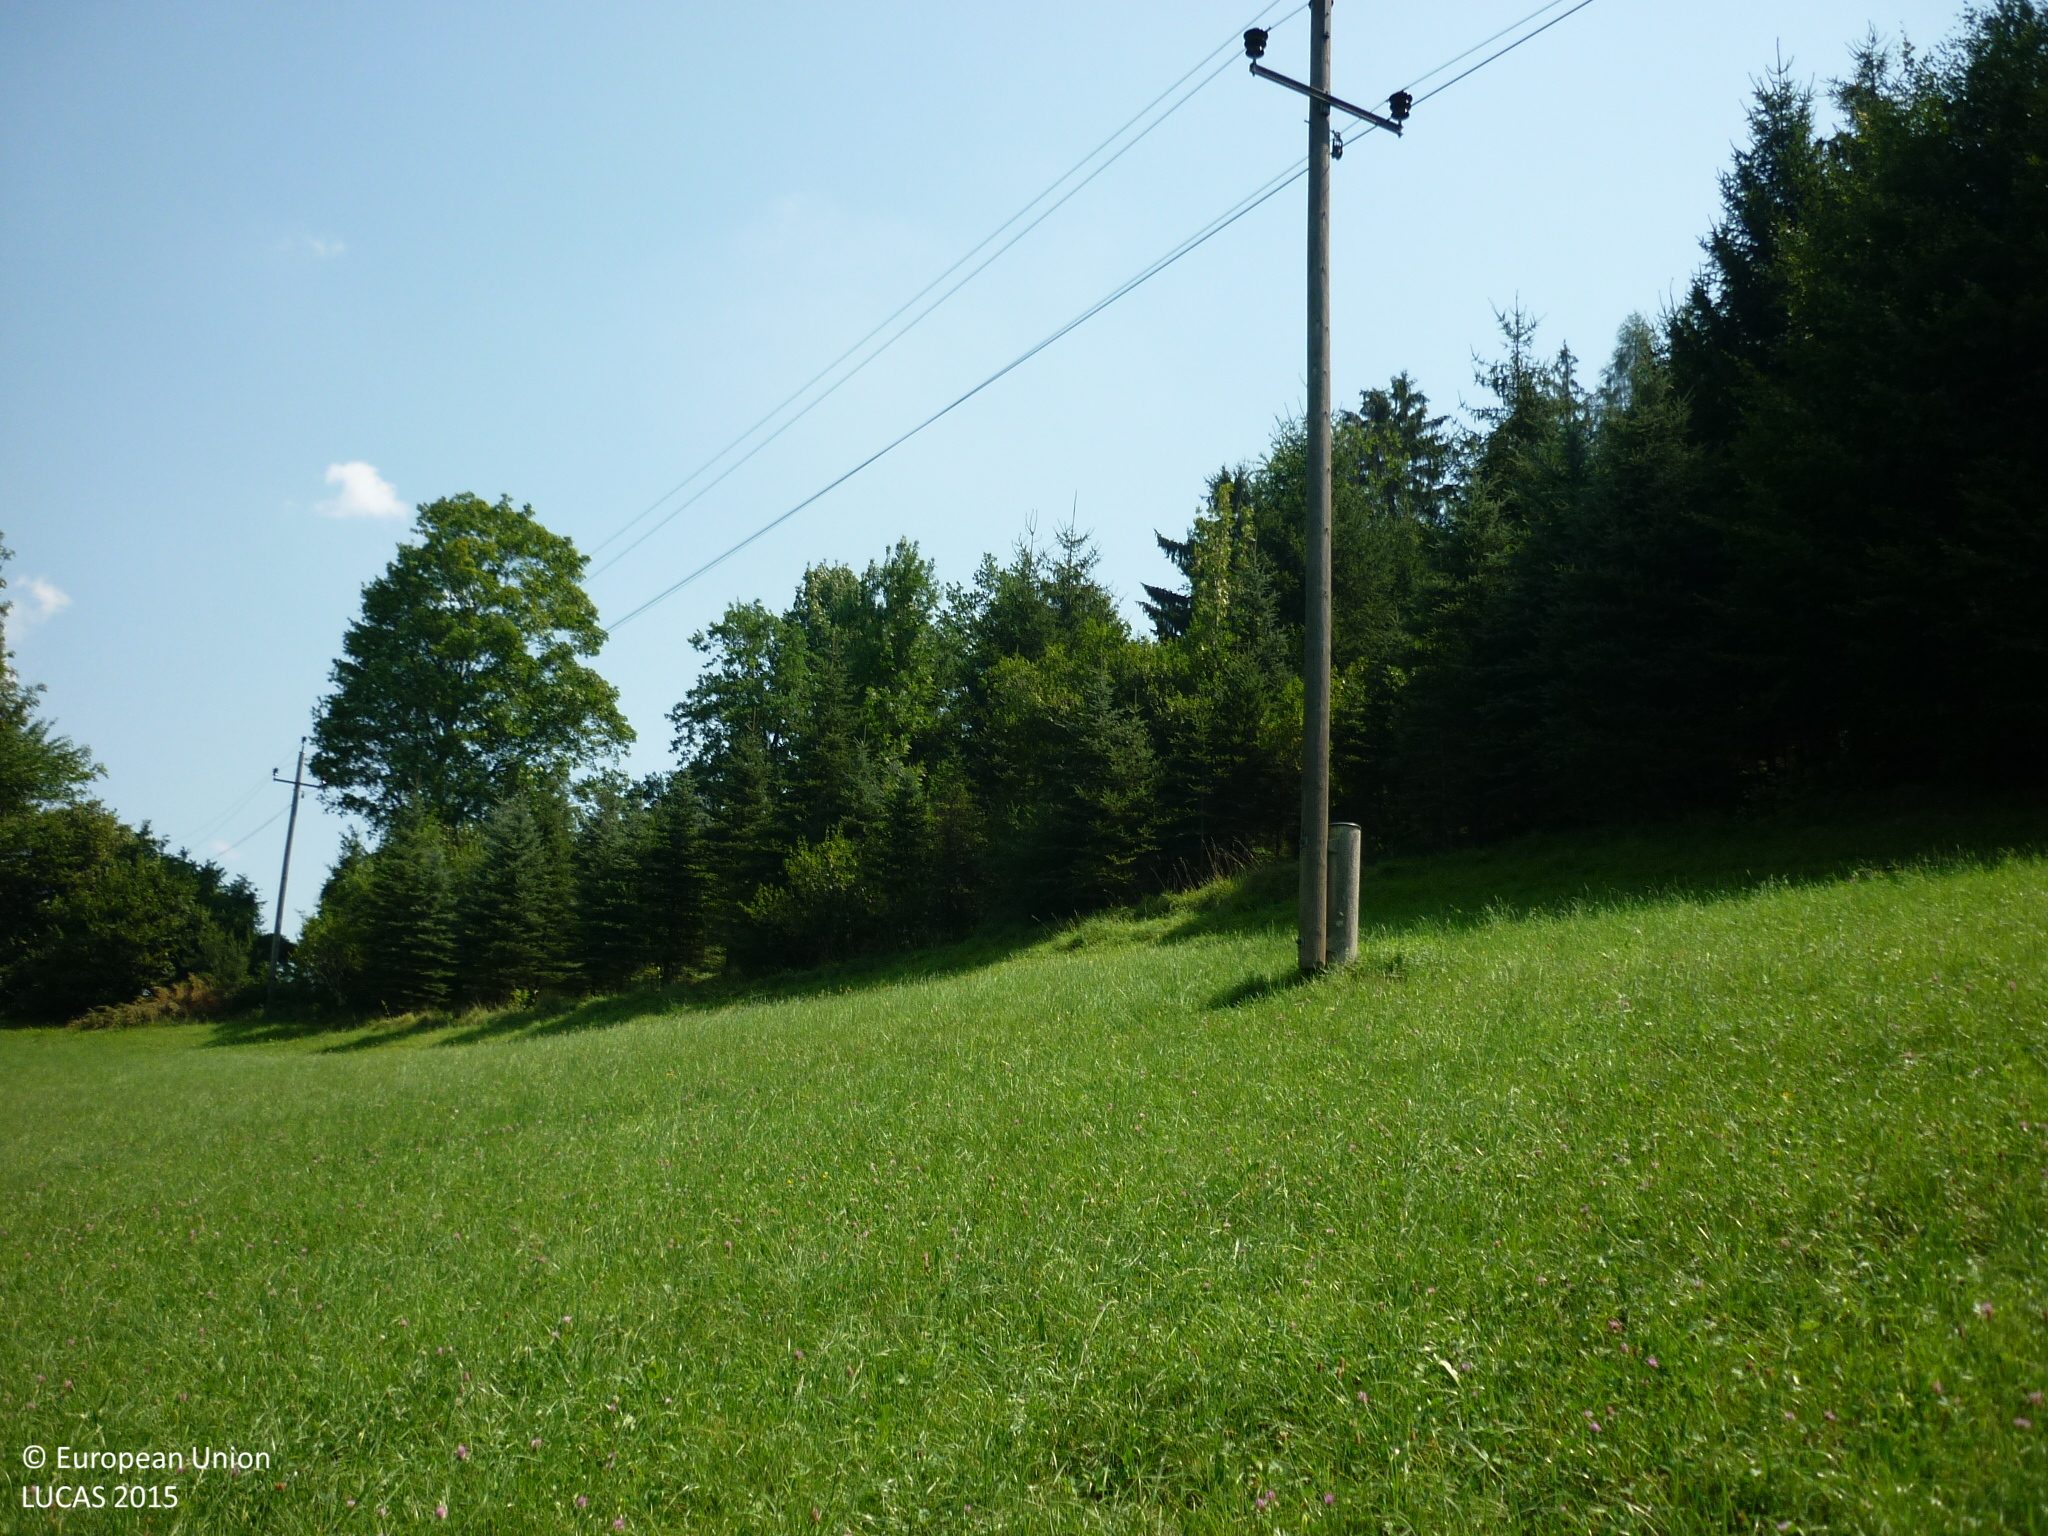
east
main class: Grassland
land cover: Grassland without tree/shrub cover
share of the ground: > 75 %
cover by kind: herbaceous plants 100 %
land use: Agriculture (excluding fallow land and kitchen gardens)
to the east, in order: Grassland without tree/shrub cover; Electric lines; Grassland without tree/shrub cover; Spruce dominated coniferous woodland; Broadleaved woodland; Fences; Grassland without tree/shrub cover; Fences; Grassland without tree/shrub cover
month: August
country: AT
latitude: 47.8893
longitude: 14.6944
